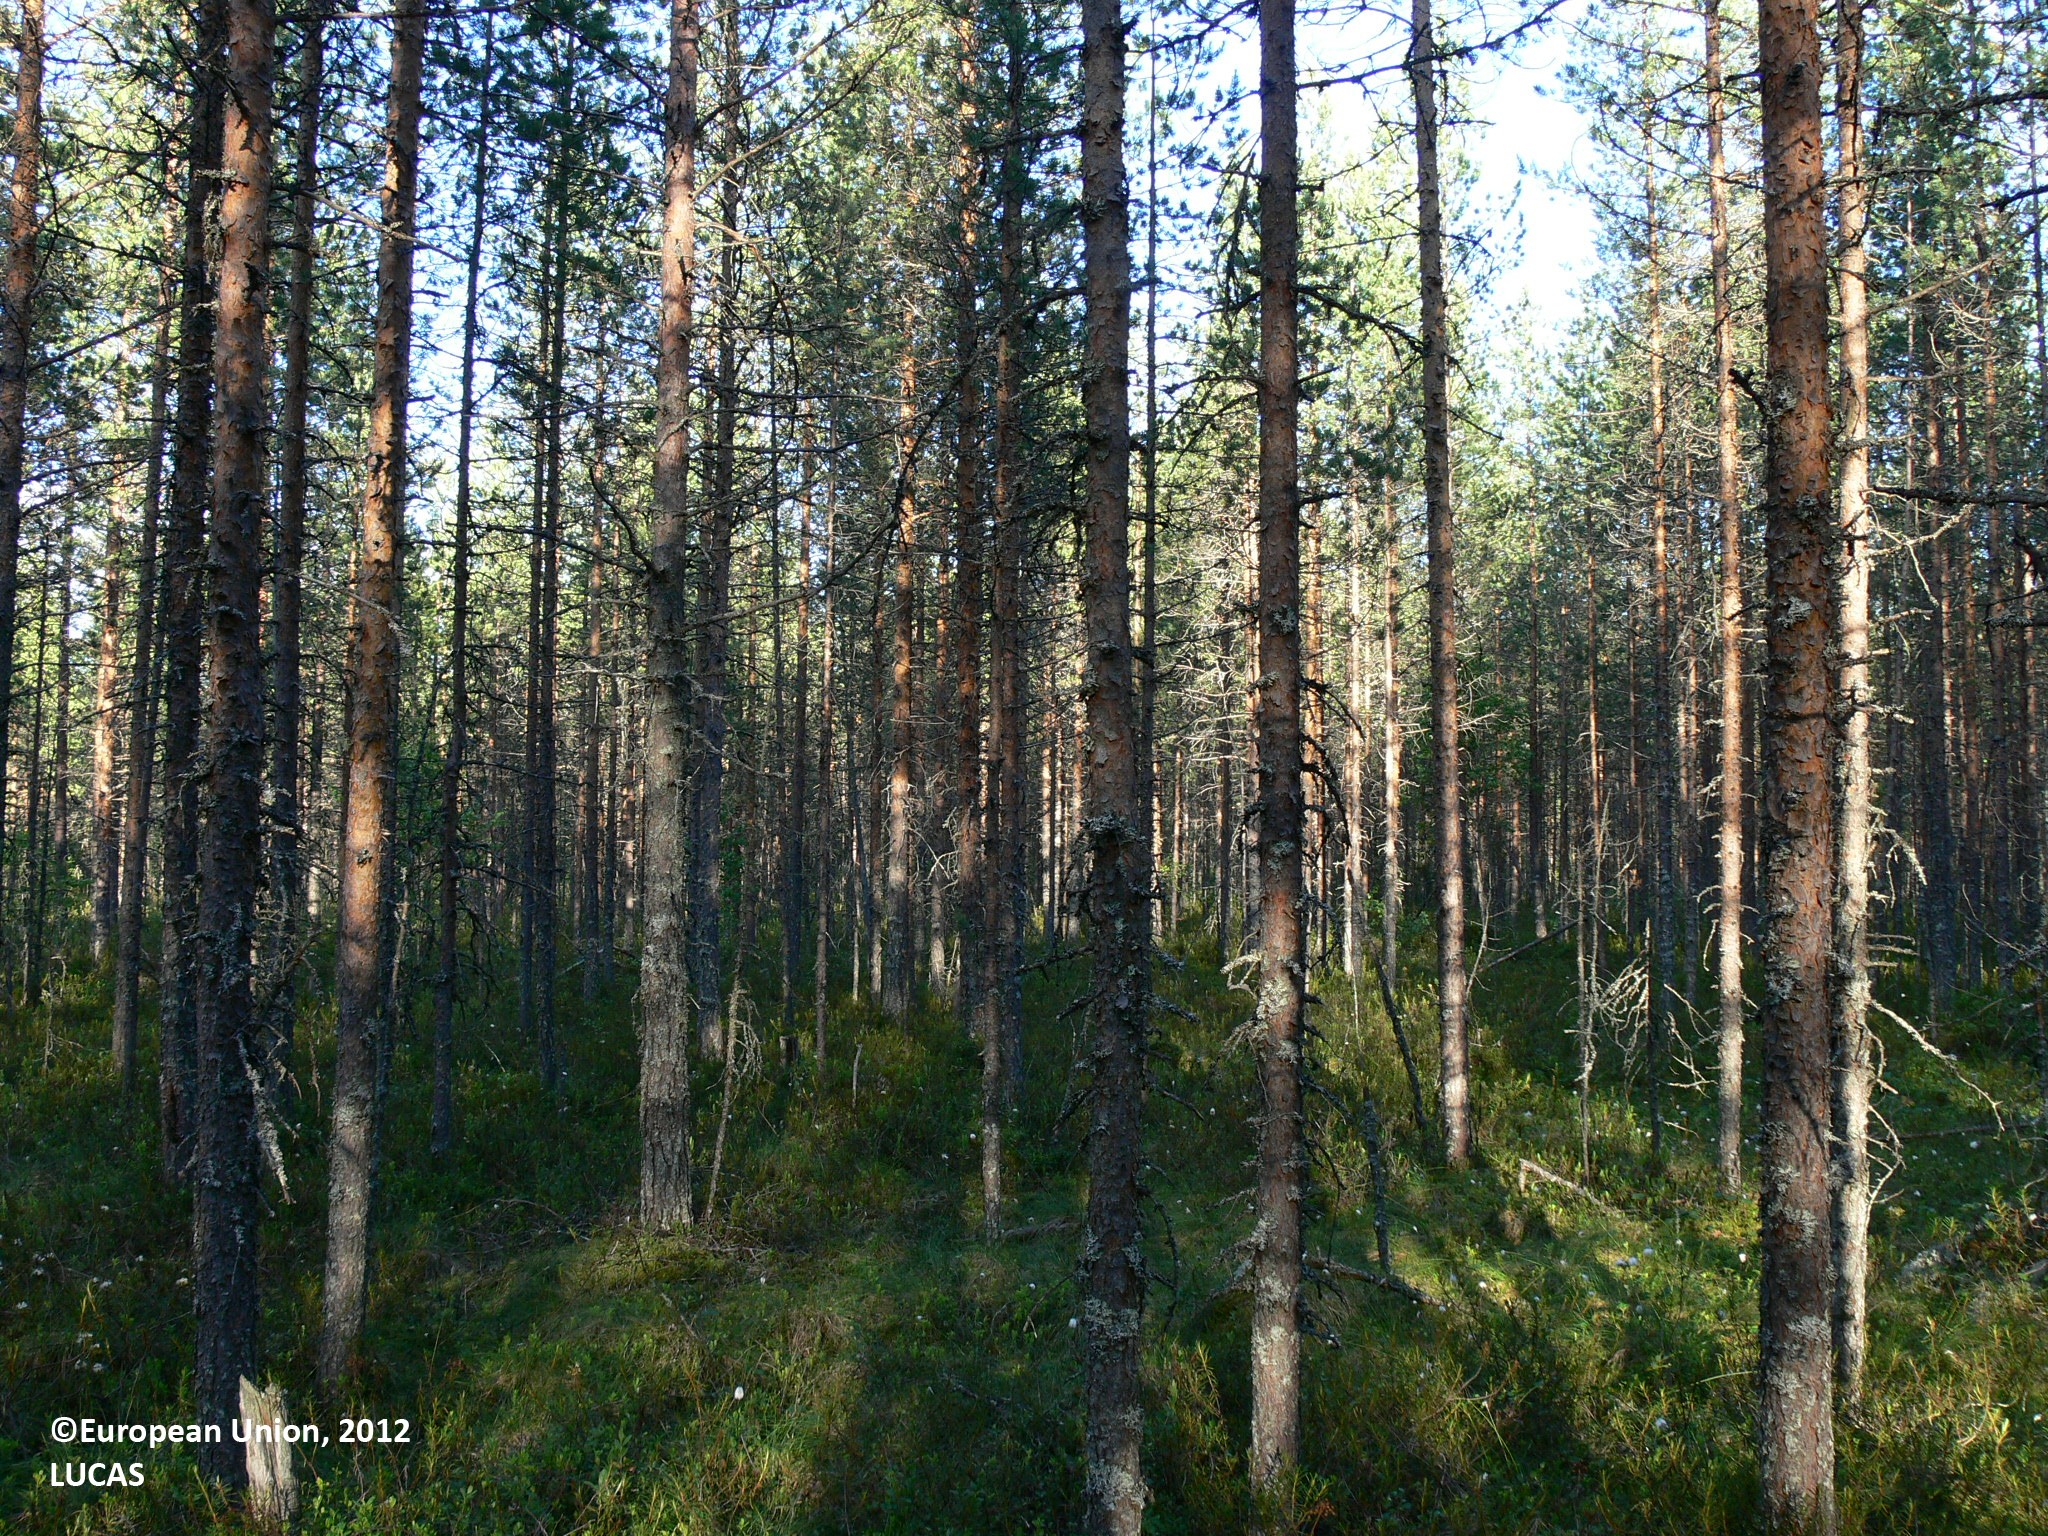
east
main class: Woodland
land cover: Pine dominated coniferous woodland
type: boreal forest
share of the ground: > 75 %
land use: Forestry
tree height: > 5 m
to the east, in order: Pine dominated coniferous woodland; Ditches and canals; Pine dominated coniferous woodland; Ditches and canals; Pine dominated coniferous woodland; Ditches and canals; Pine dominated mixed woodland; Pine dominated coniferous woodland; Pine dominated mixed woodland; Pine dominated coniferous woodland
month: July
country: FI
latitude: 62.9037
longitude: 31.0238
